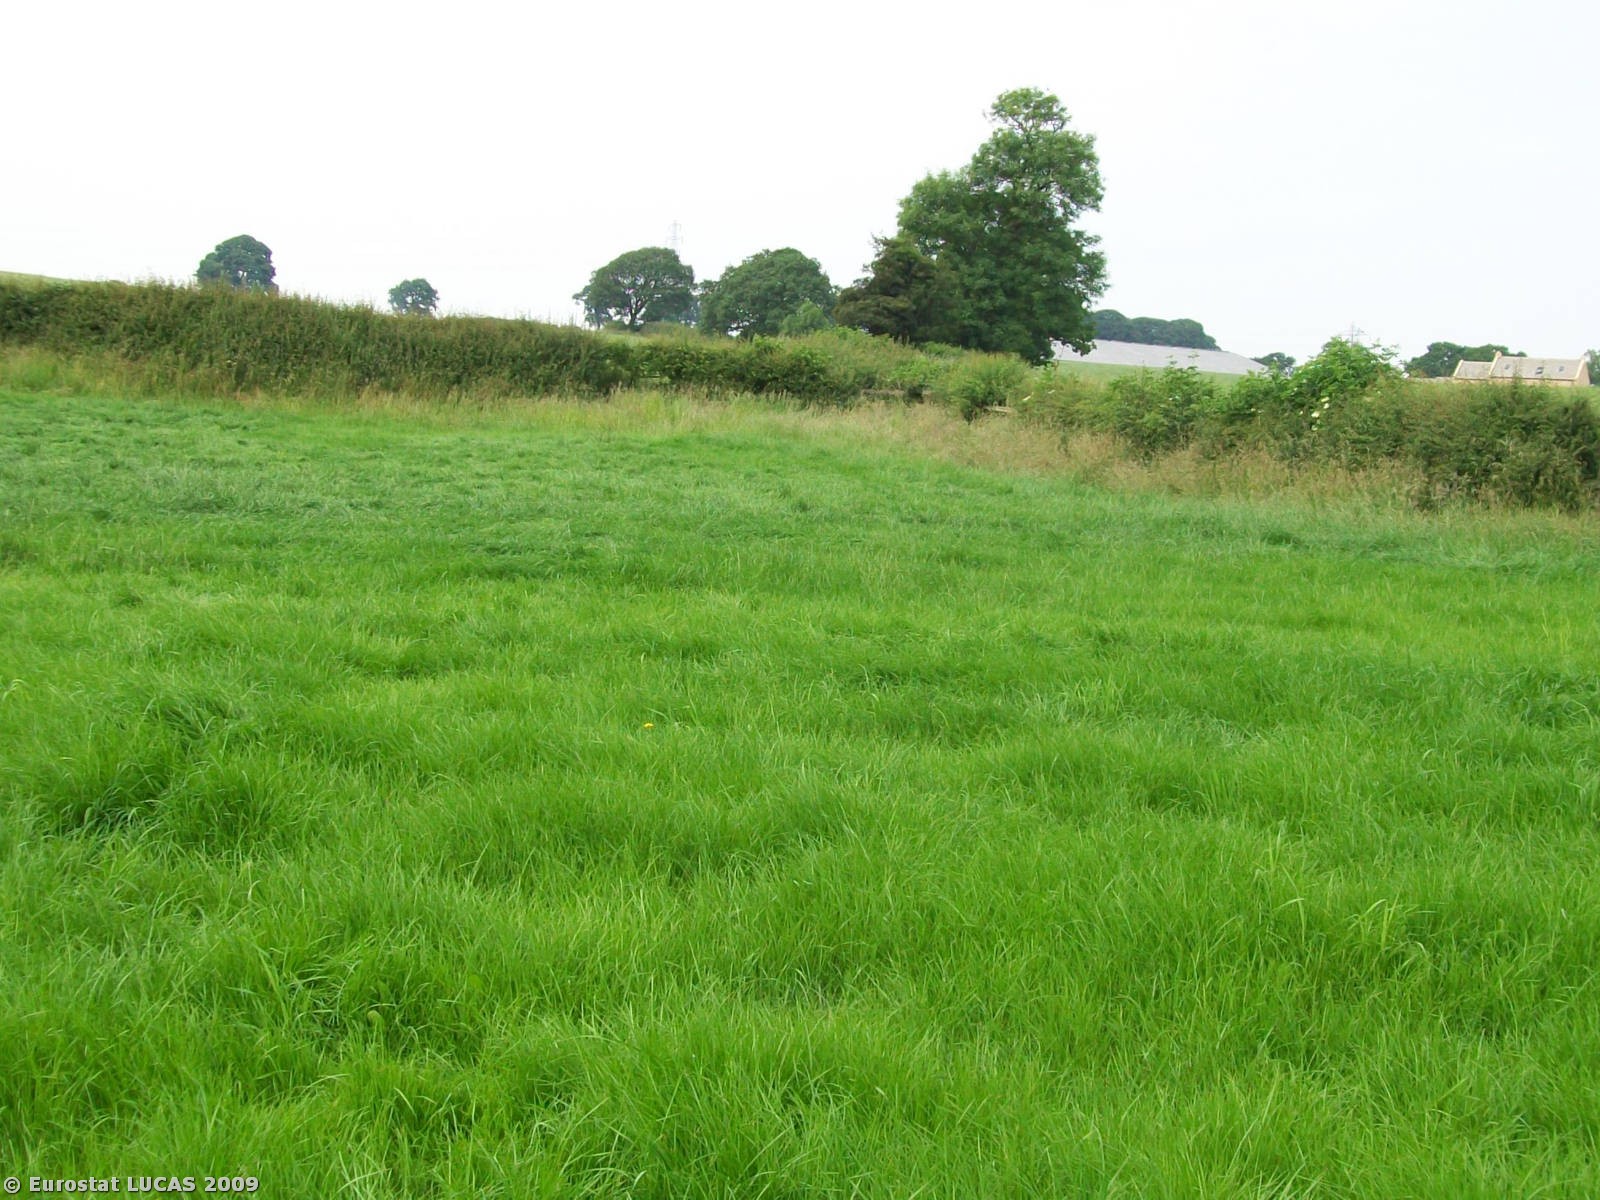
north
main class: Grassland
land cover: Grassland without tree/shrub cover
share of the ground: < 10 %
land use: Agriculture (excluding fallow land and kitchen gardens)
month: June
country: GB
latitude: 54.0670
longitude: -1.5250
